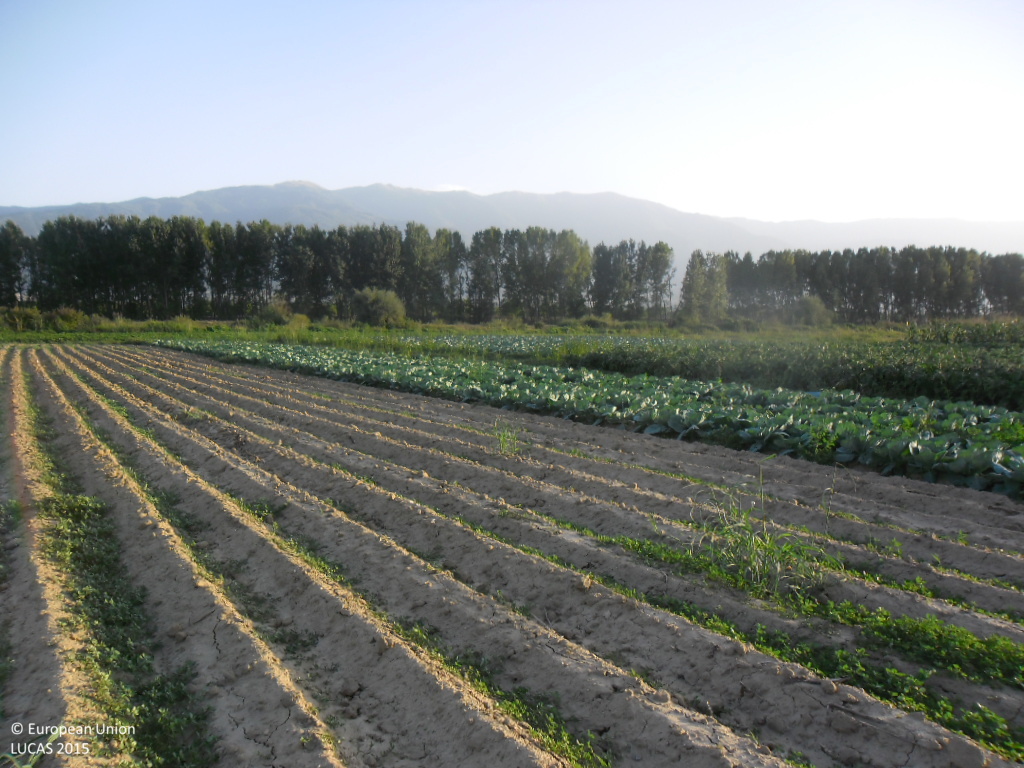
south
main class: Cropland
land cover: Potatoes
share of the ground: < 10 %
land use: Agriculture (excluding fallow land and kitchen gardens)
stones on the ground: < 10 %
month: September
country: BG
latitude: 41.4245
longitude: 23.1690
